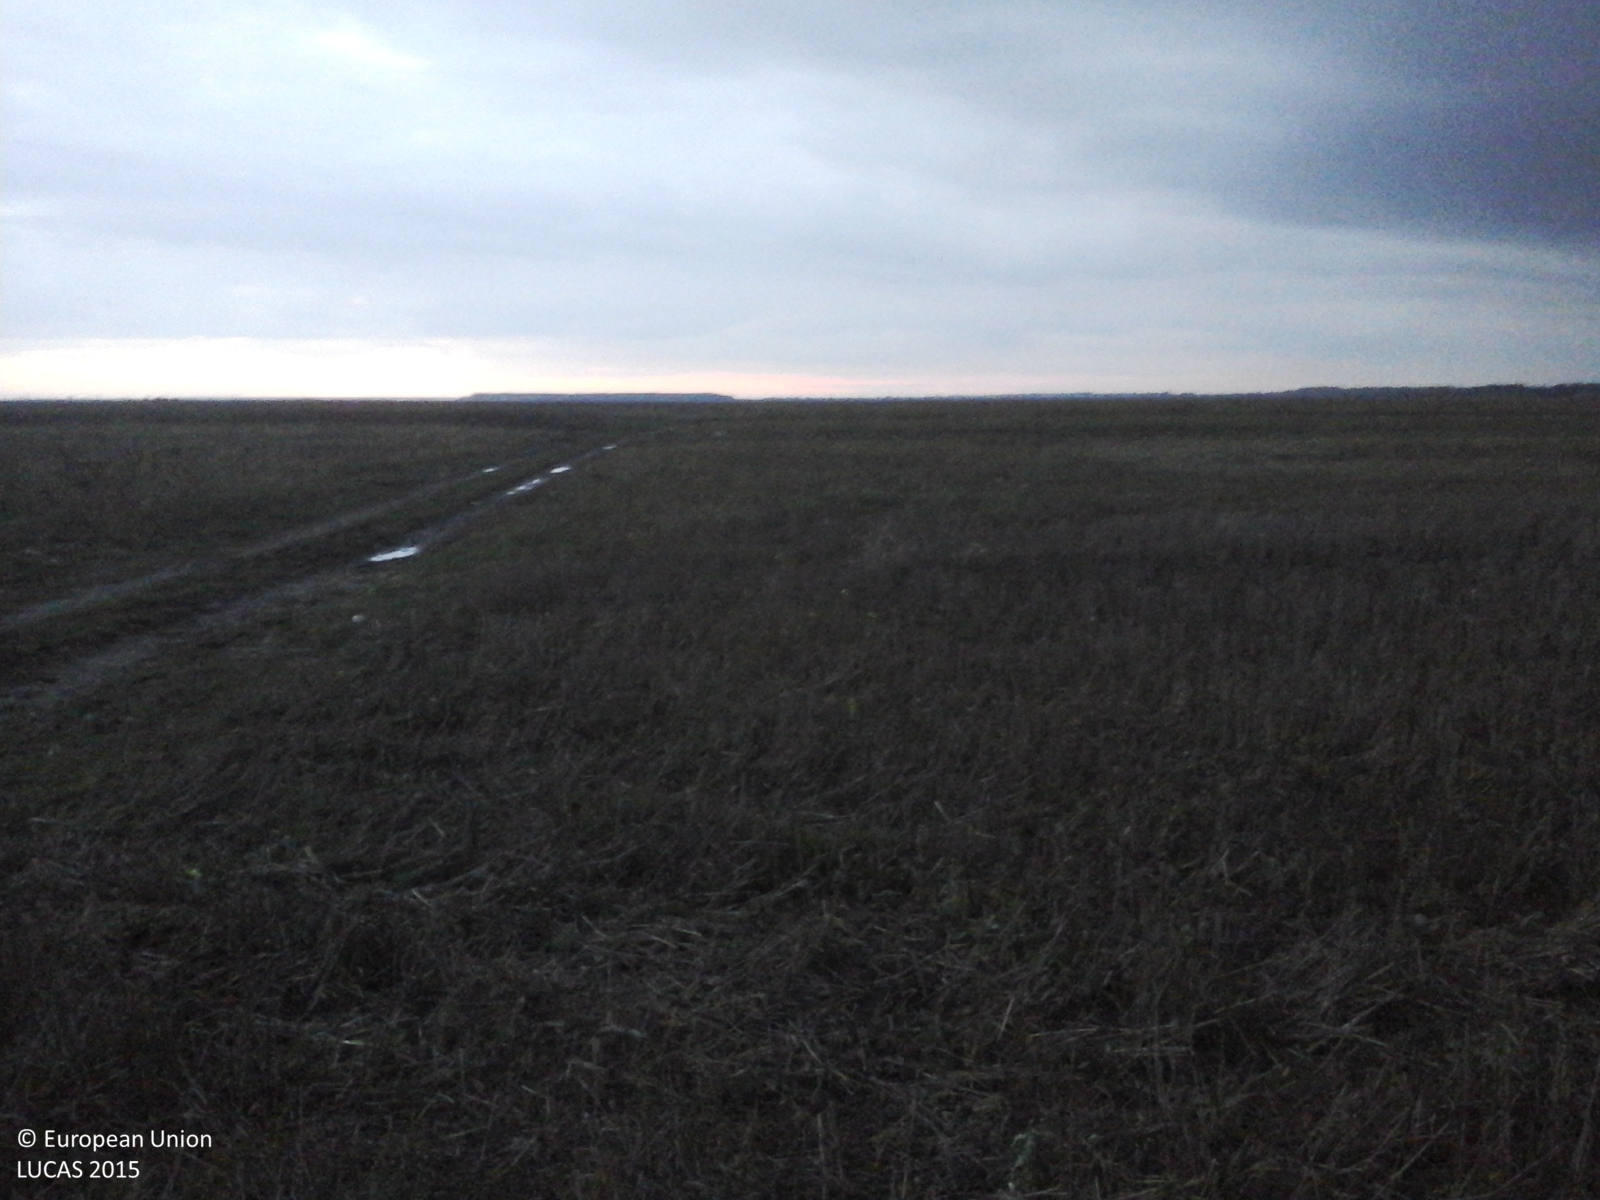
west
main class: Grassland
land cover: Spontaneously vegetated surfaces
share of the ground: > 75 %
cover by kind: herbaceous plants 100 %
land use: Fallow land
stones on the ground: < 10 %
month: October
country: RO
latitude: 44.7227
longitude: 25.9488
